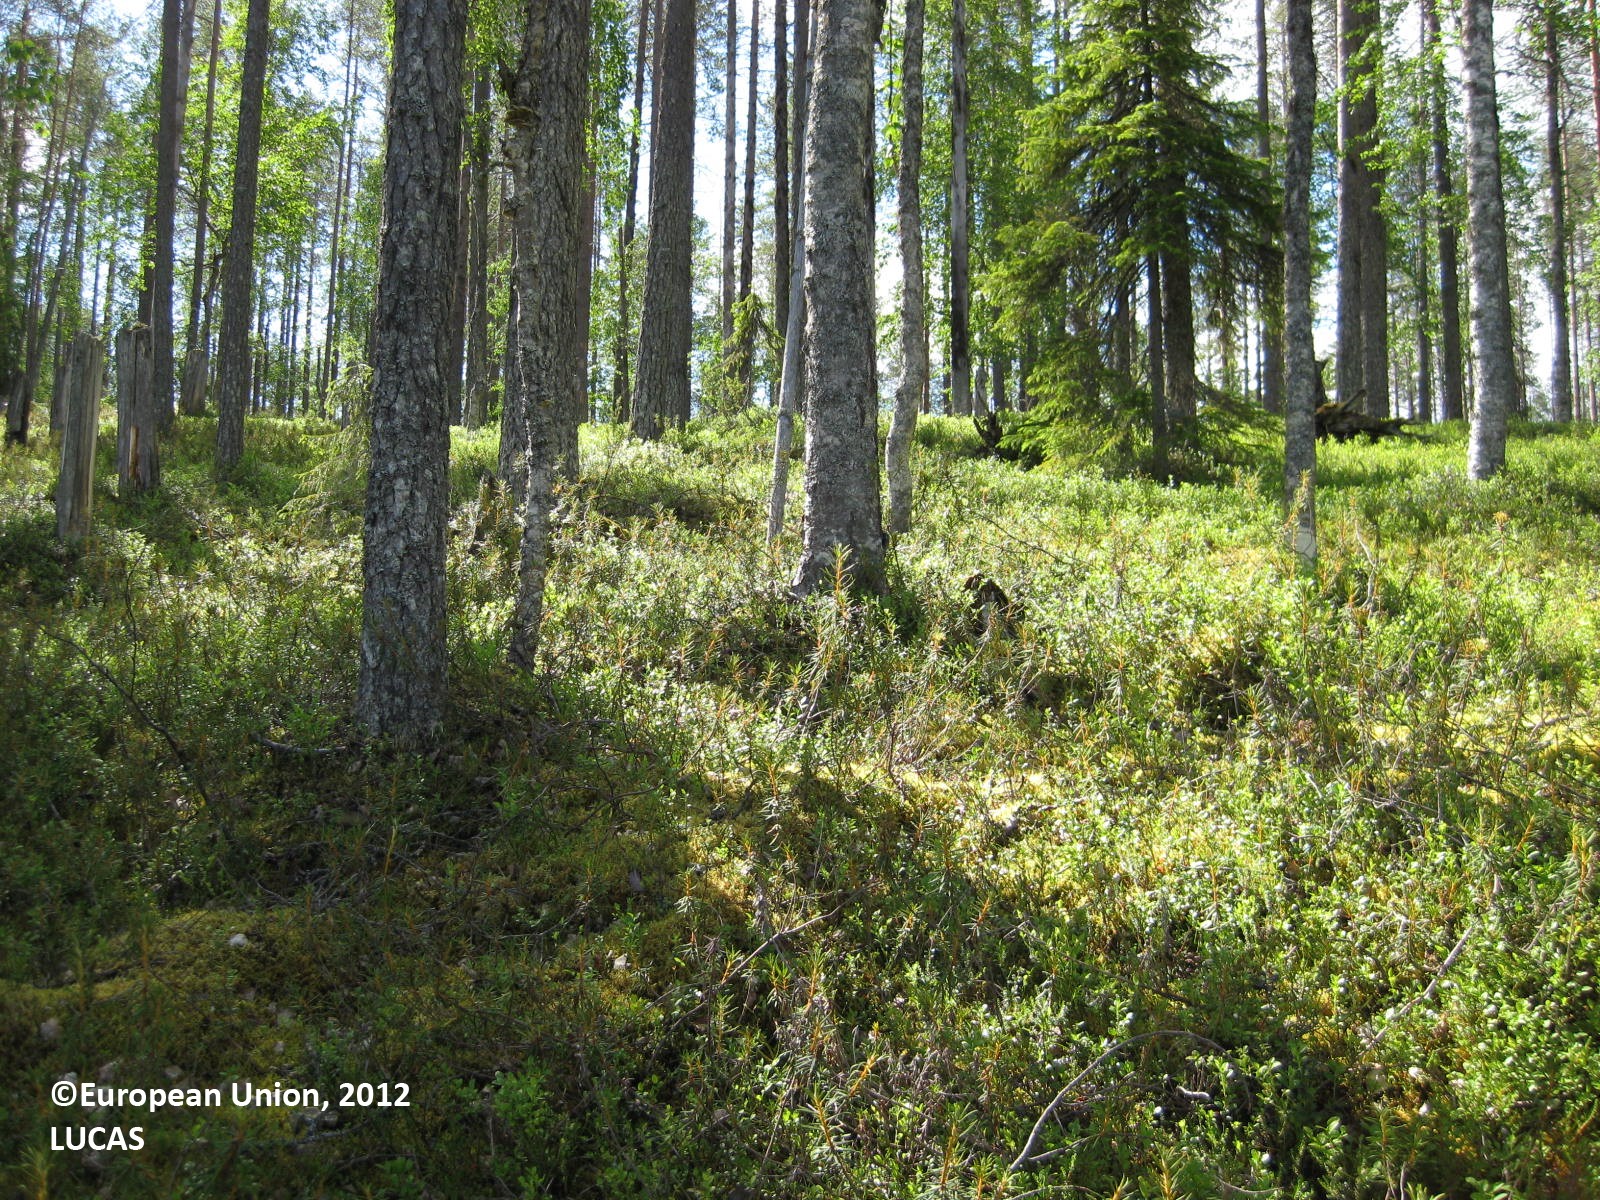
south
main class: Woodland
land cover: Pine dominated mixed woodland
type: boreal forest
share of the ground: > 75 %
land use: Forestry
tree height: > 5 m
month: July
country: FI
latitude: 65.6936
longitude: 29.8707
